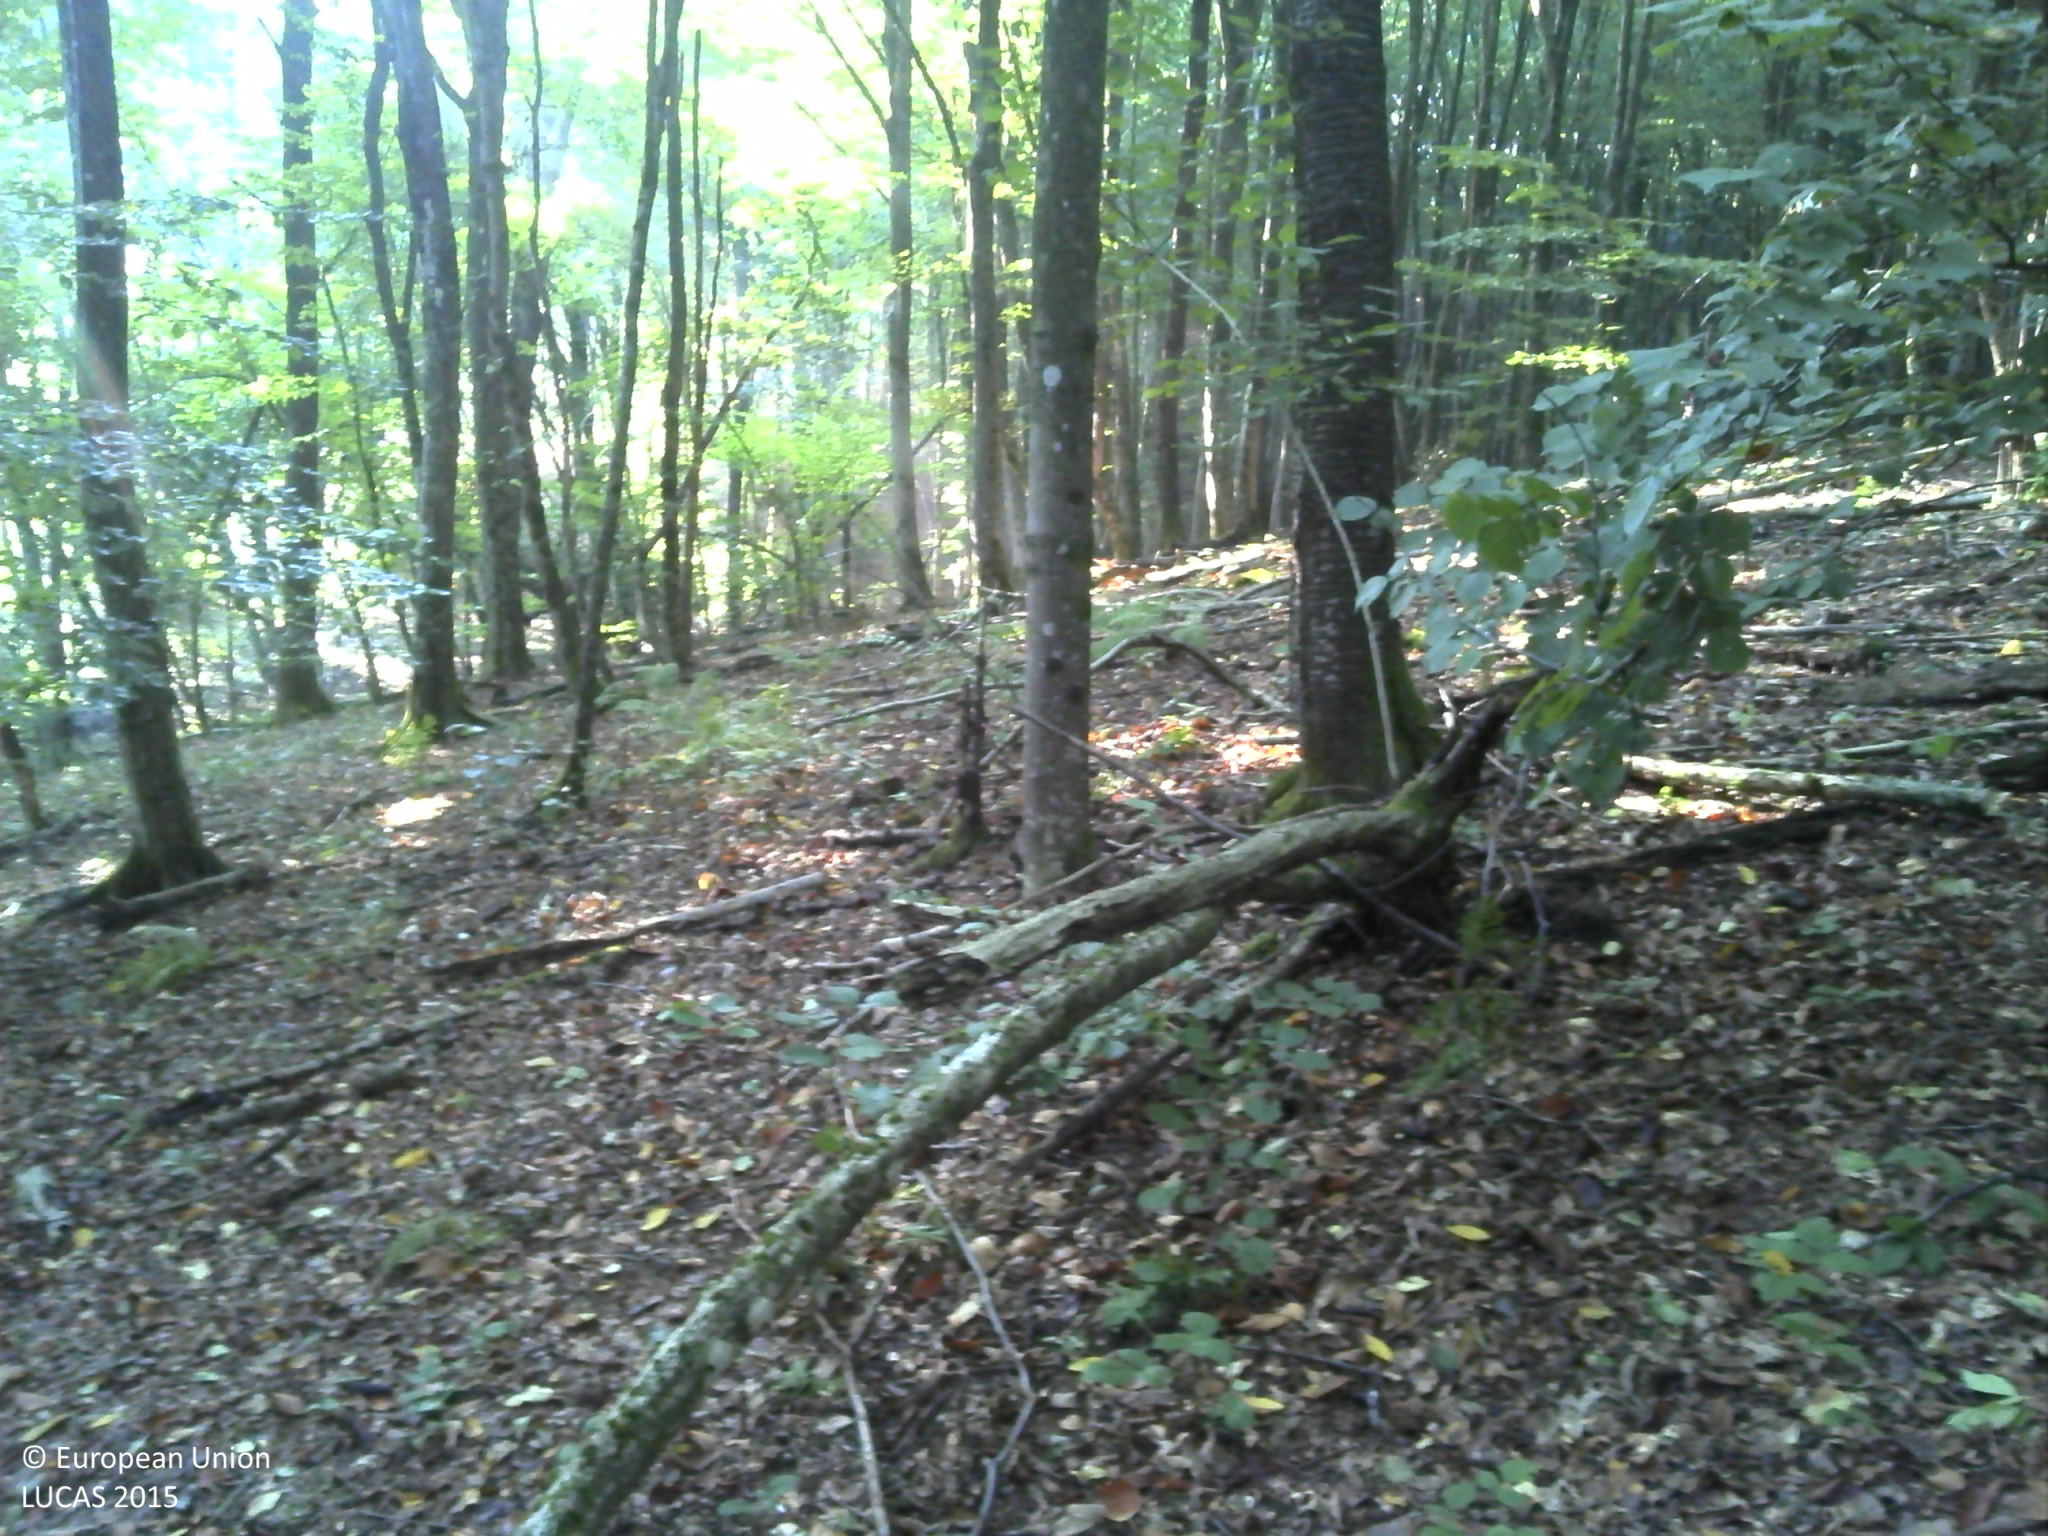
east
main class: Woodland
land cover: Broadleaved woodland
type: beech forest
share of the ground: > 75 %
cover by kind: broadleaved forest trees 100 %
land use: Forestry
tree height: > 5 m
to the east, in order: Broadleaved woodland
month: August
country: HR
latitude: 45.3440
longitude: 16.1356
